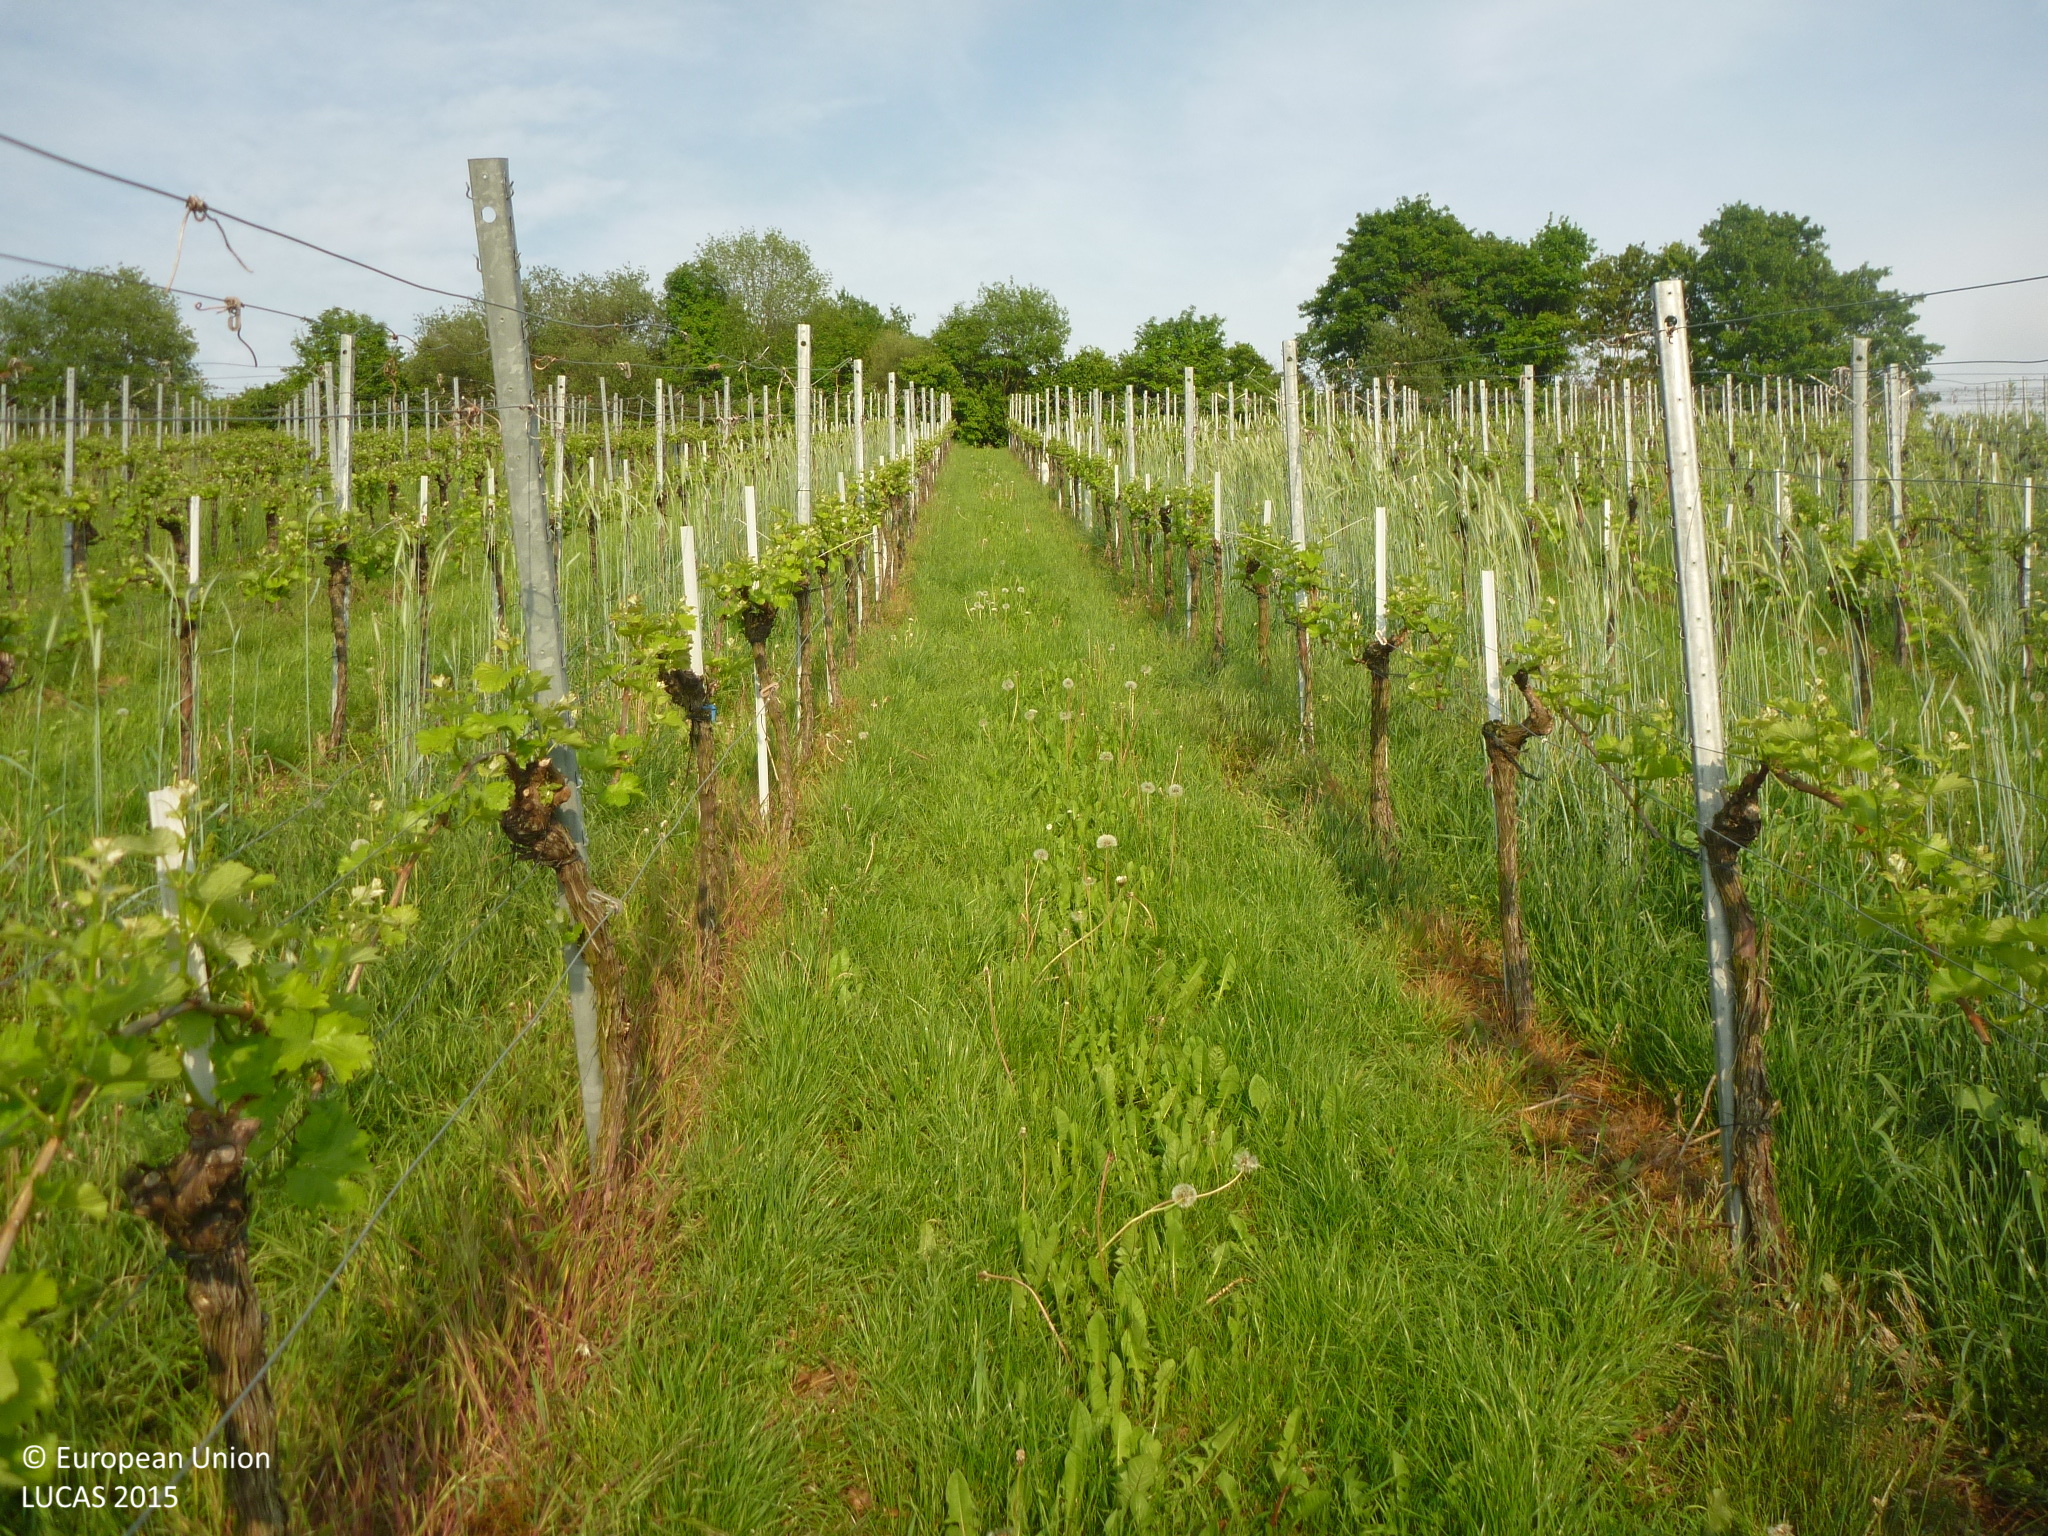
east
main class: Cropland
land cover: Vineyards
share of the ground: 10 - 25 %
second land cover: Grassland without tree/shrub cover
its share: > 75 %
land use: Agriculture (excluding fallow land and kitchen gardens)
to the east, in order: Vineyards; Grassland without tree/shrub cover; Paved roads, cycling and walking lanes; Grass margins; Broadleaved woodland; Grassland with sparse tree/shrub cover; Paved roads, cycling and walking lanes; Broadleaved woodland; Spontaneously vegetated surfaces; Grassland without tree/shrub cover; Apple fruit
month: May
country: DE
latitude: 48.7978
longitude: 9.4149
